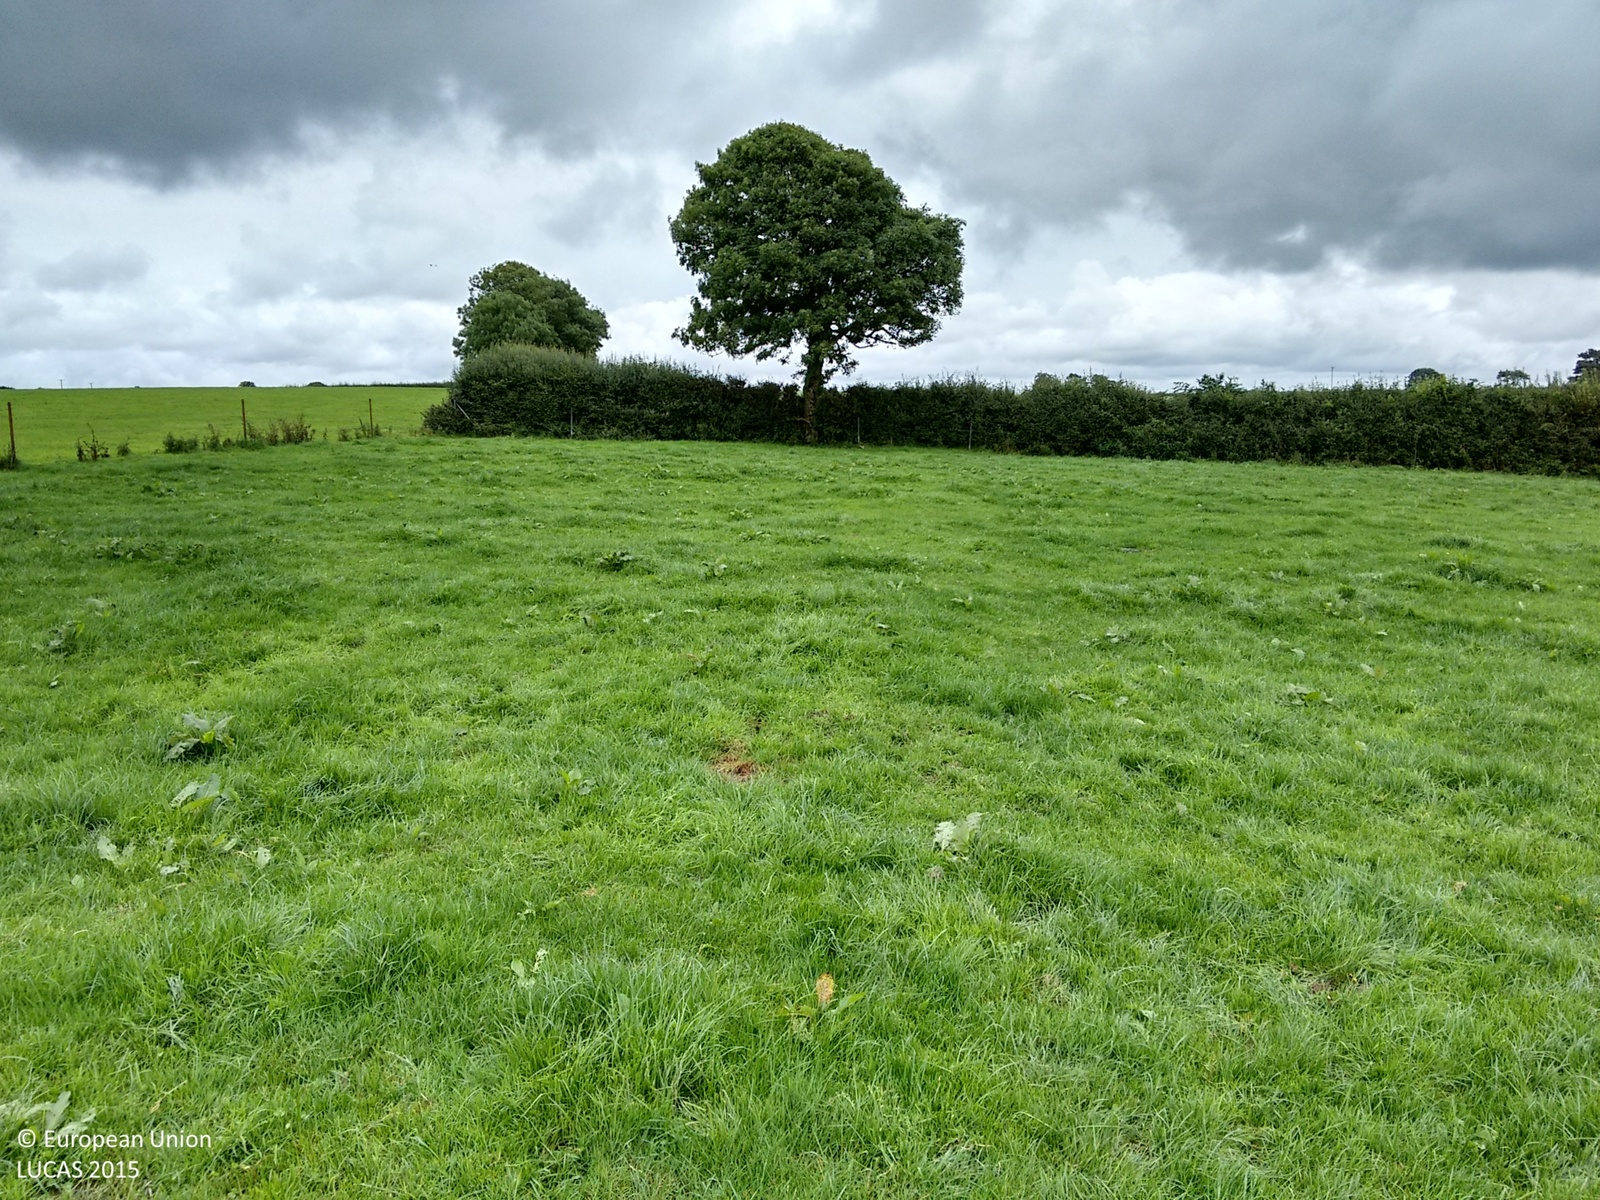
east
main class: Grassland
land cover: Grassland without tree/shrub cover
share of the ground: > 75 %
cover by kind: herbaceous plants 100 %
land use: Agriculture (excluding fallow land and kitchen gardens)
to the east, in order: Grassland without tree/shrub cover; Fences; Single bushes/trees; Managed hedges; Fences; Temporary grasslands
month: August
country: GB
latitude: 51.8708
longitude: -4.8852
